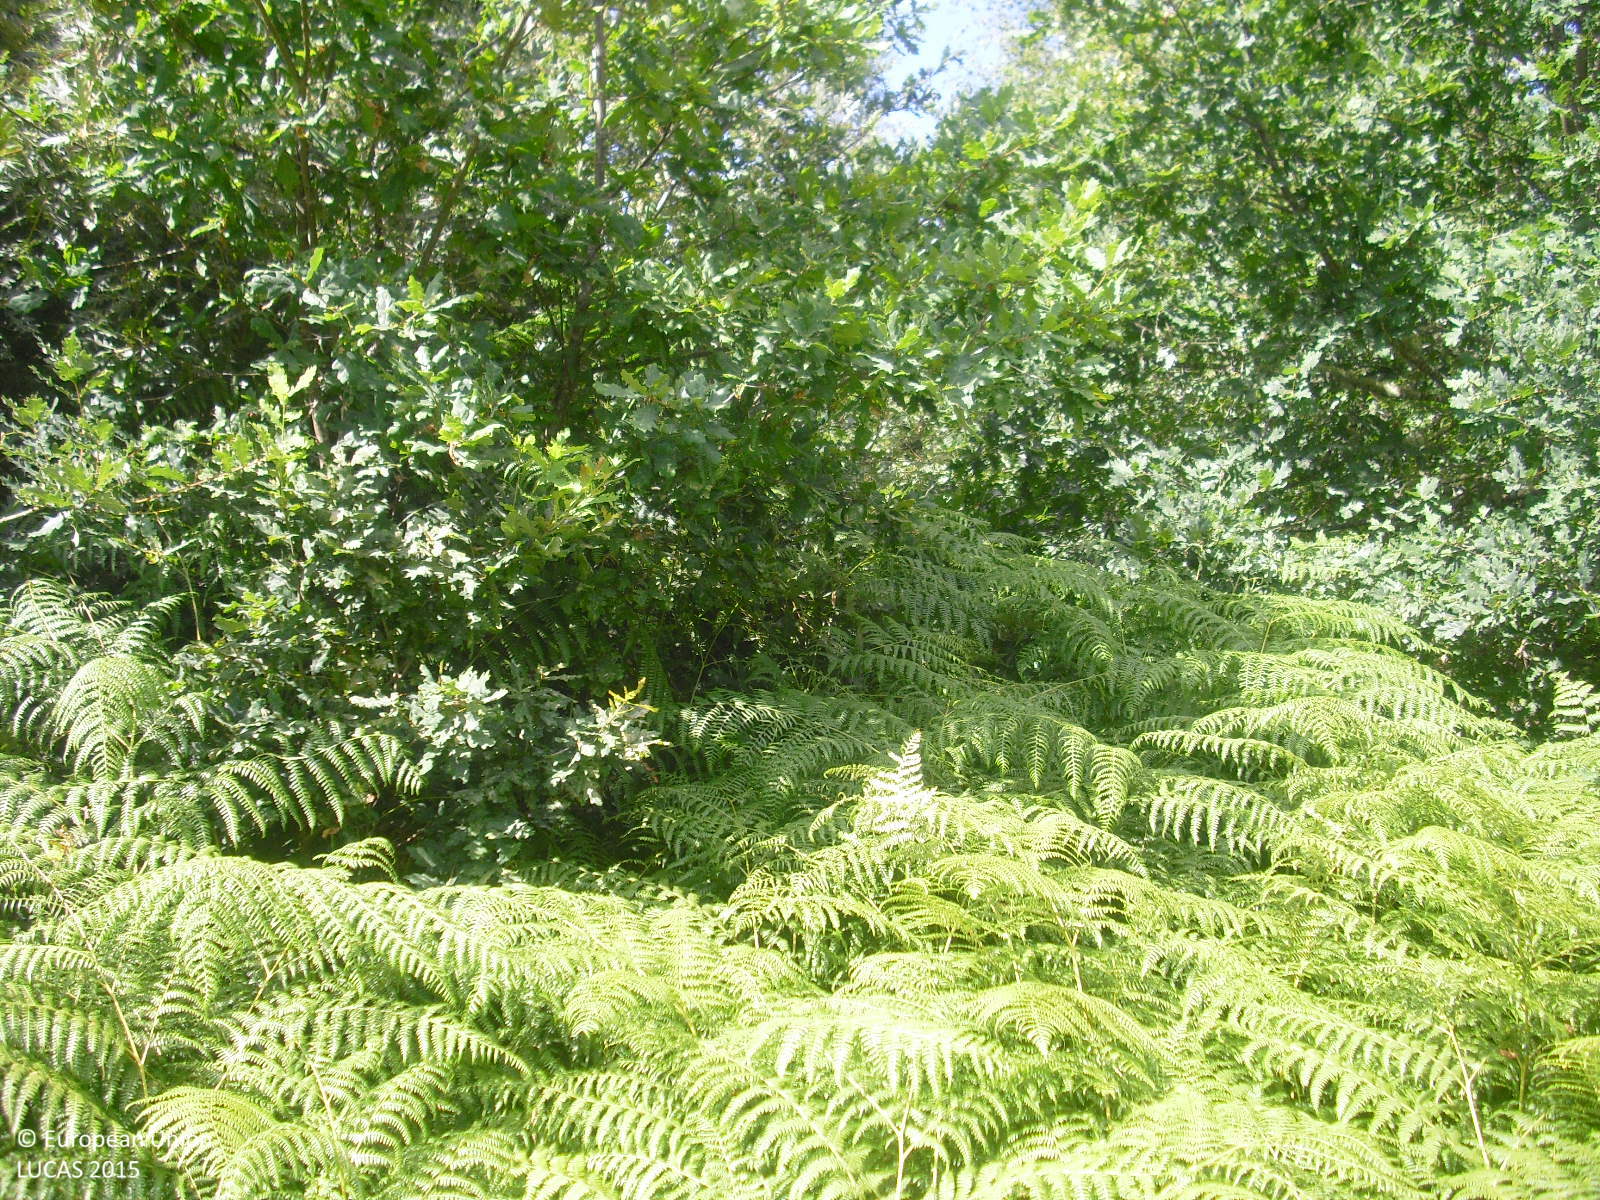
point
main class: Woodland
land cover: Broadleaved woodland
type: thermophilous deciduous forest
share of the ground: 50 - 75 %
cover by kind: broadleaved forest trees 60 %, shrubs 30 %, herbaceous plants 10 %
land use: Forestry
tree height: > 5 m
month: July
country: ES
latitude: 42.3376
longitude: -7.6830
